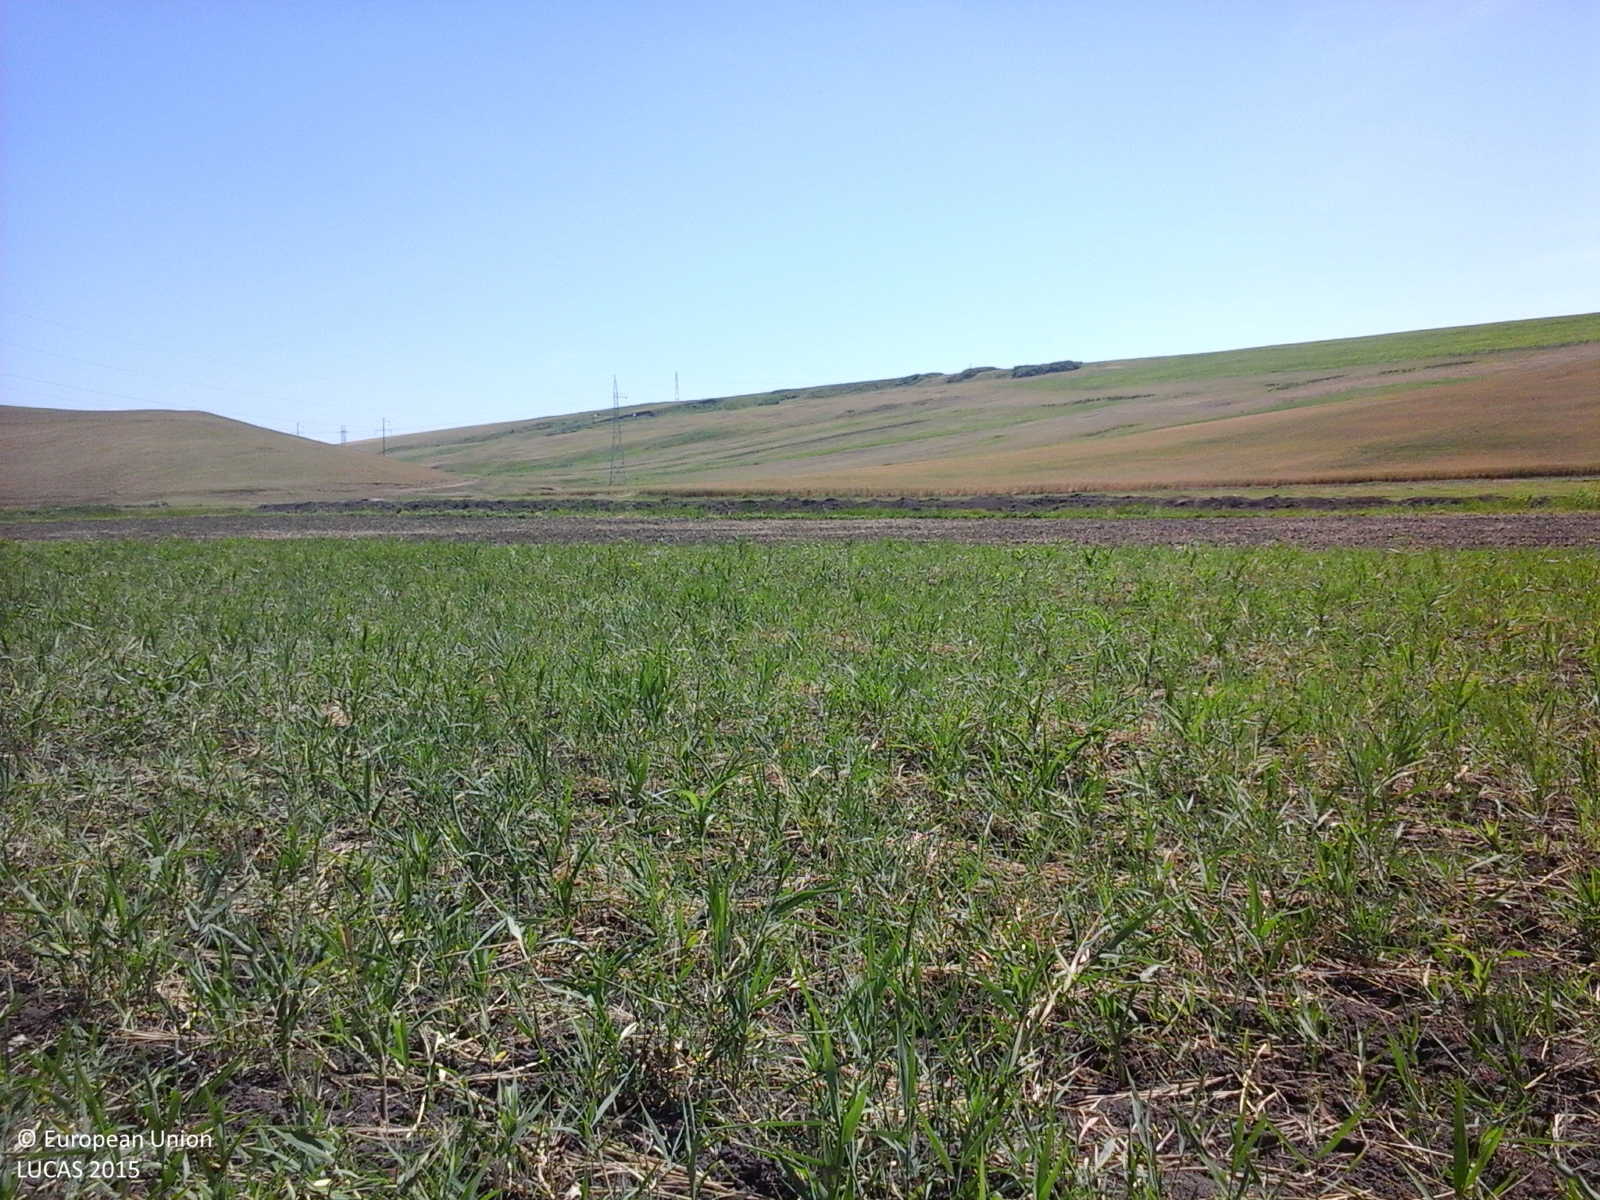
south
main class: Grassland
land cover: Spontaneously vegetated surfaces
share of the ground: > 75 %
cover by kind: herbaceous plants 100 %
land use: Agriculture (excluding fallow land and kitchen gardens)
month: June
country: RO
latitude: 47.2533
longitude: 27.0289
